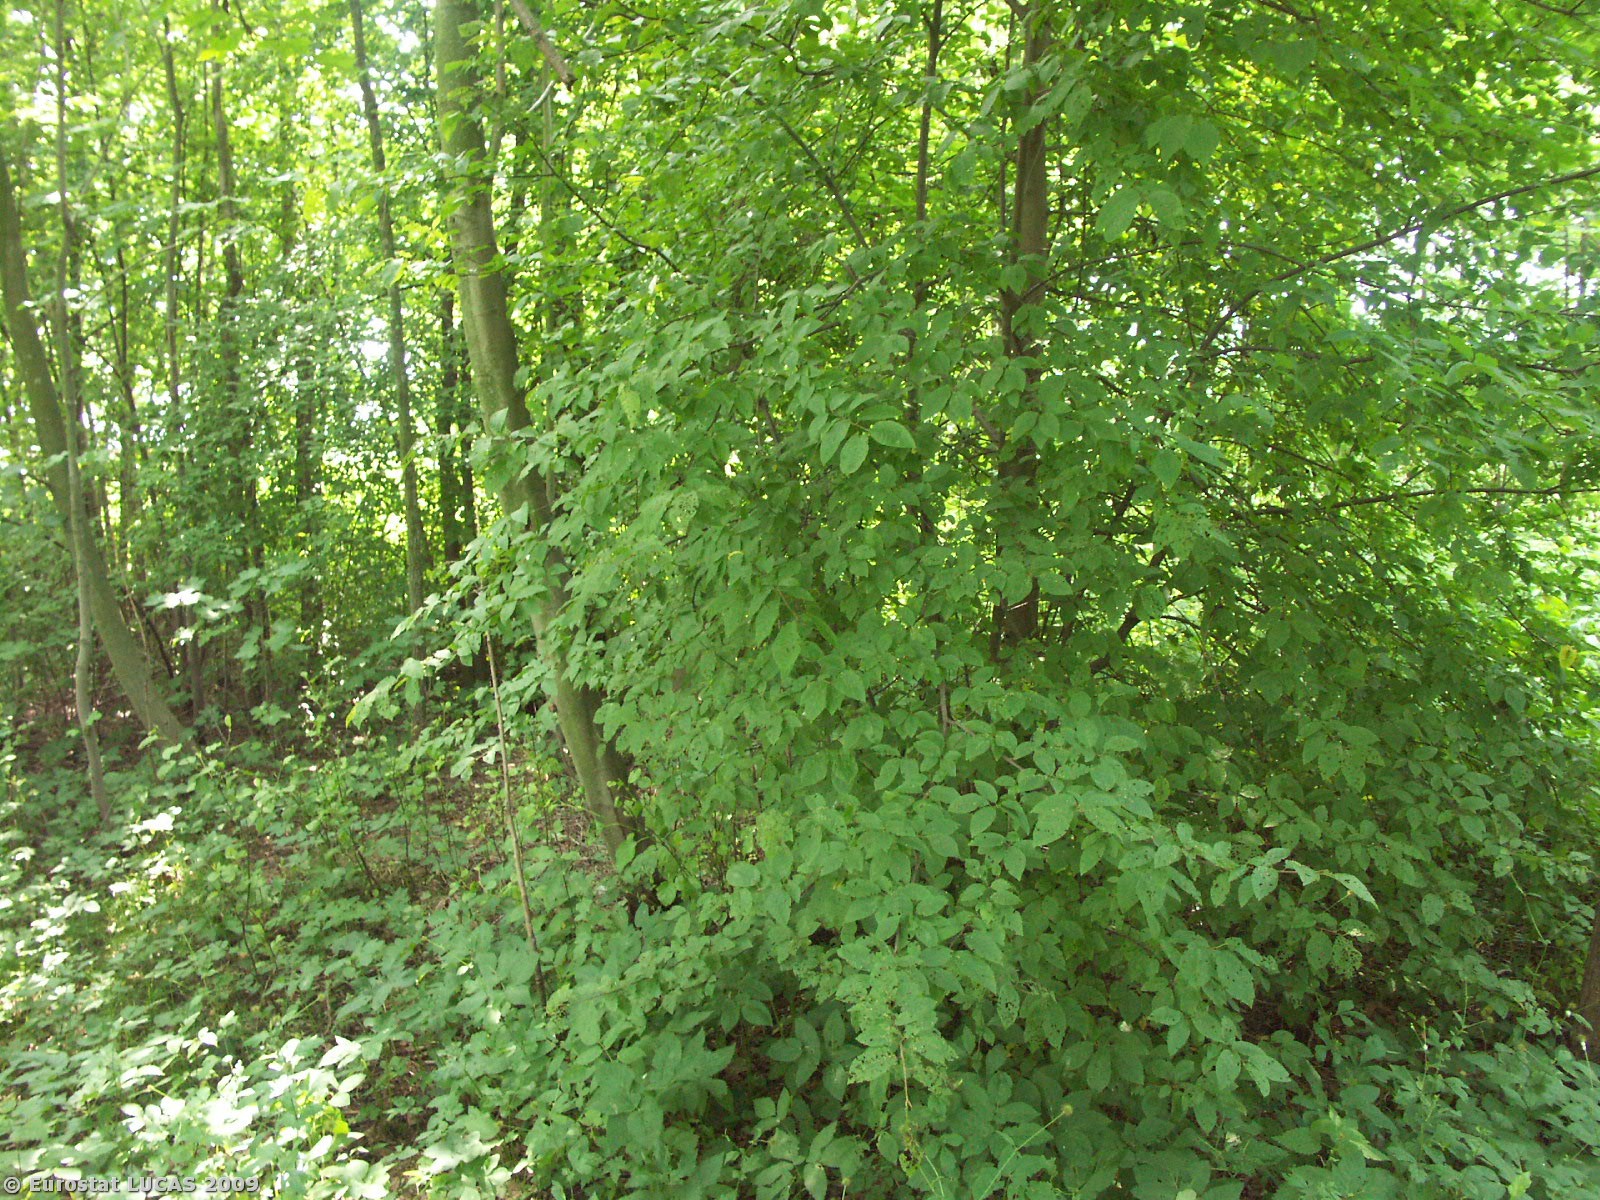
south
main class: Woodland
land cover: Broadleaved woodland
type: floodplain forest
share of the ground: > 75 %
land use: Forestry
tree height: > 5 m
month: June
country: CZ
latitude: 50.0968
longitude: 16.6764
